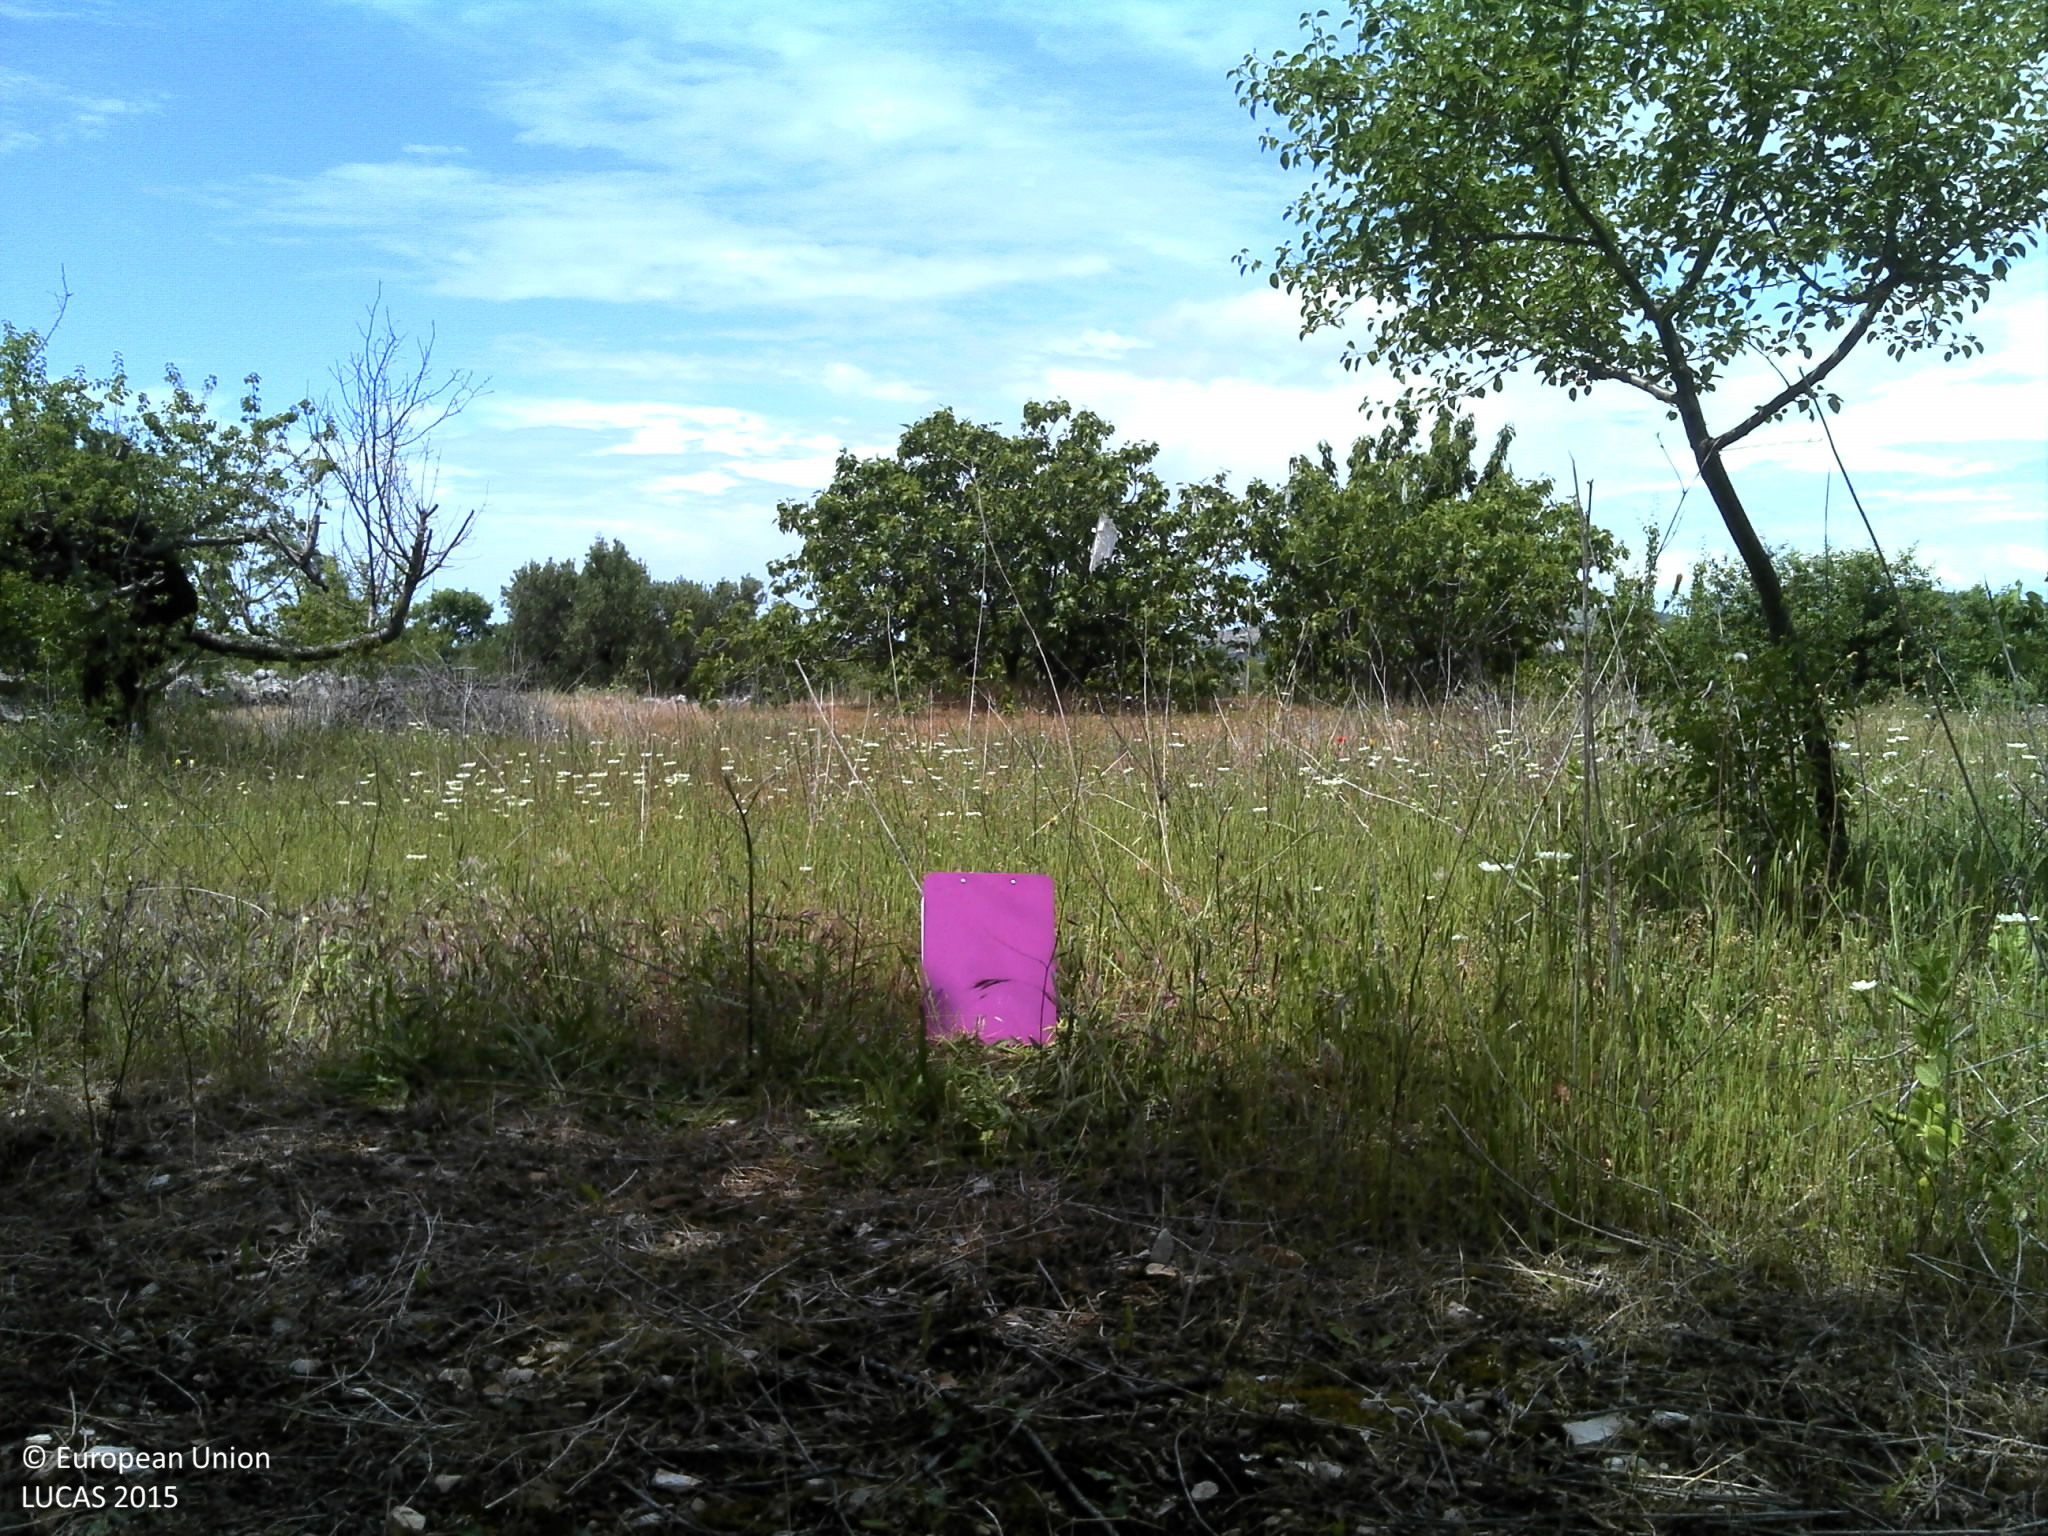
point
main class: Cropland
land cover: Cherry fruit
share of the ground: < 10 %
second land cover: Grassland without tree/shrub cover
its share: > 75 %
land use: Agriculture (excluding fallow land and kitchen gardens)
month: May
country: HR
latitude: 43.5788
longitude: 16.0214
